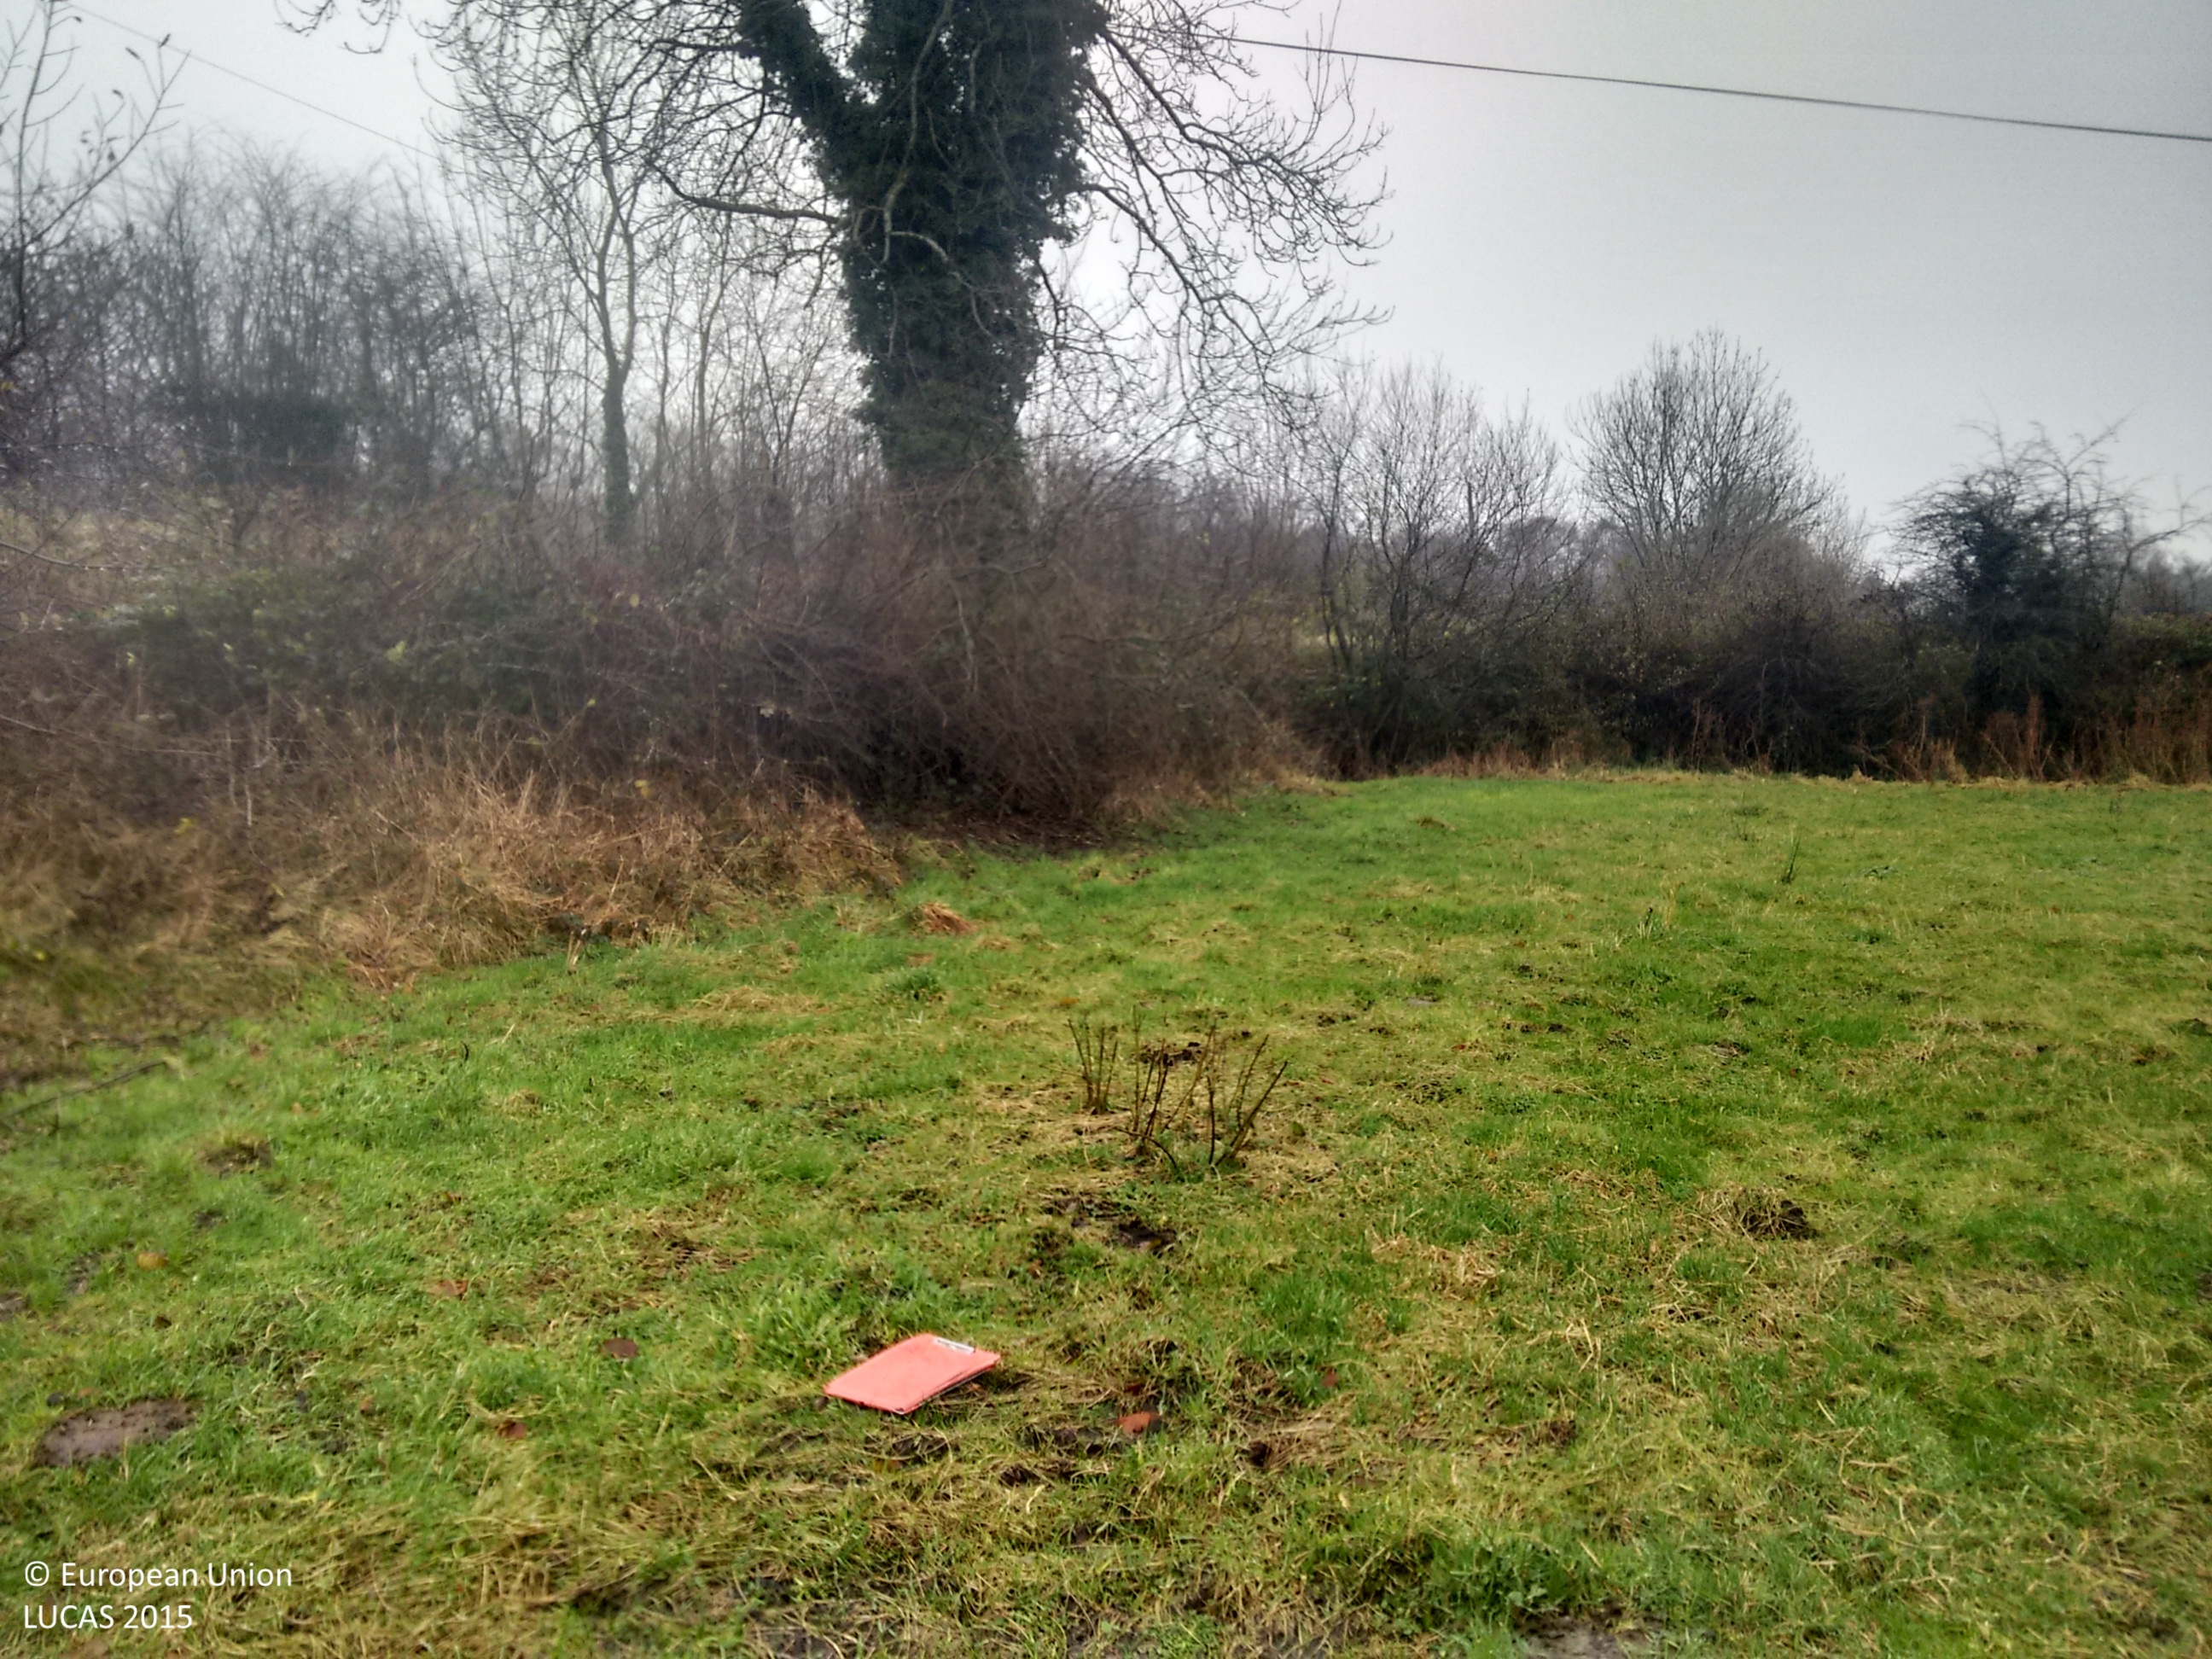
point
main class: Grassland
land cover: Grassland without tree/shrub cover
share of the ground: > 75 %
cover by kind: herbaceous plants 95 %, unconsolidated bare surface 5 %
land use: Agriculture (excluding fallow land and kitchen gardens)
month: December
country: IE
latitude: 54.1703
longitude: -7.2909
